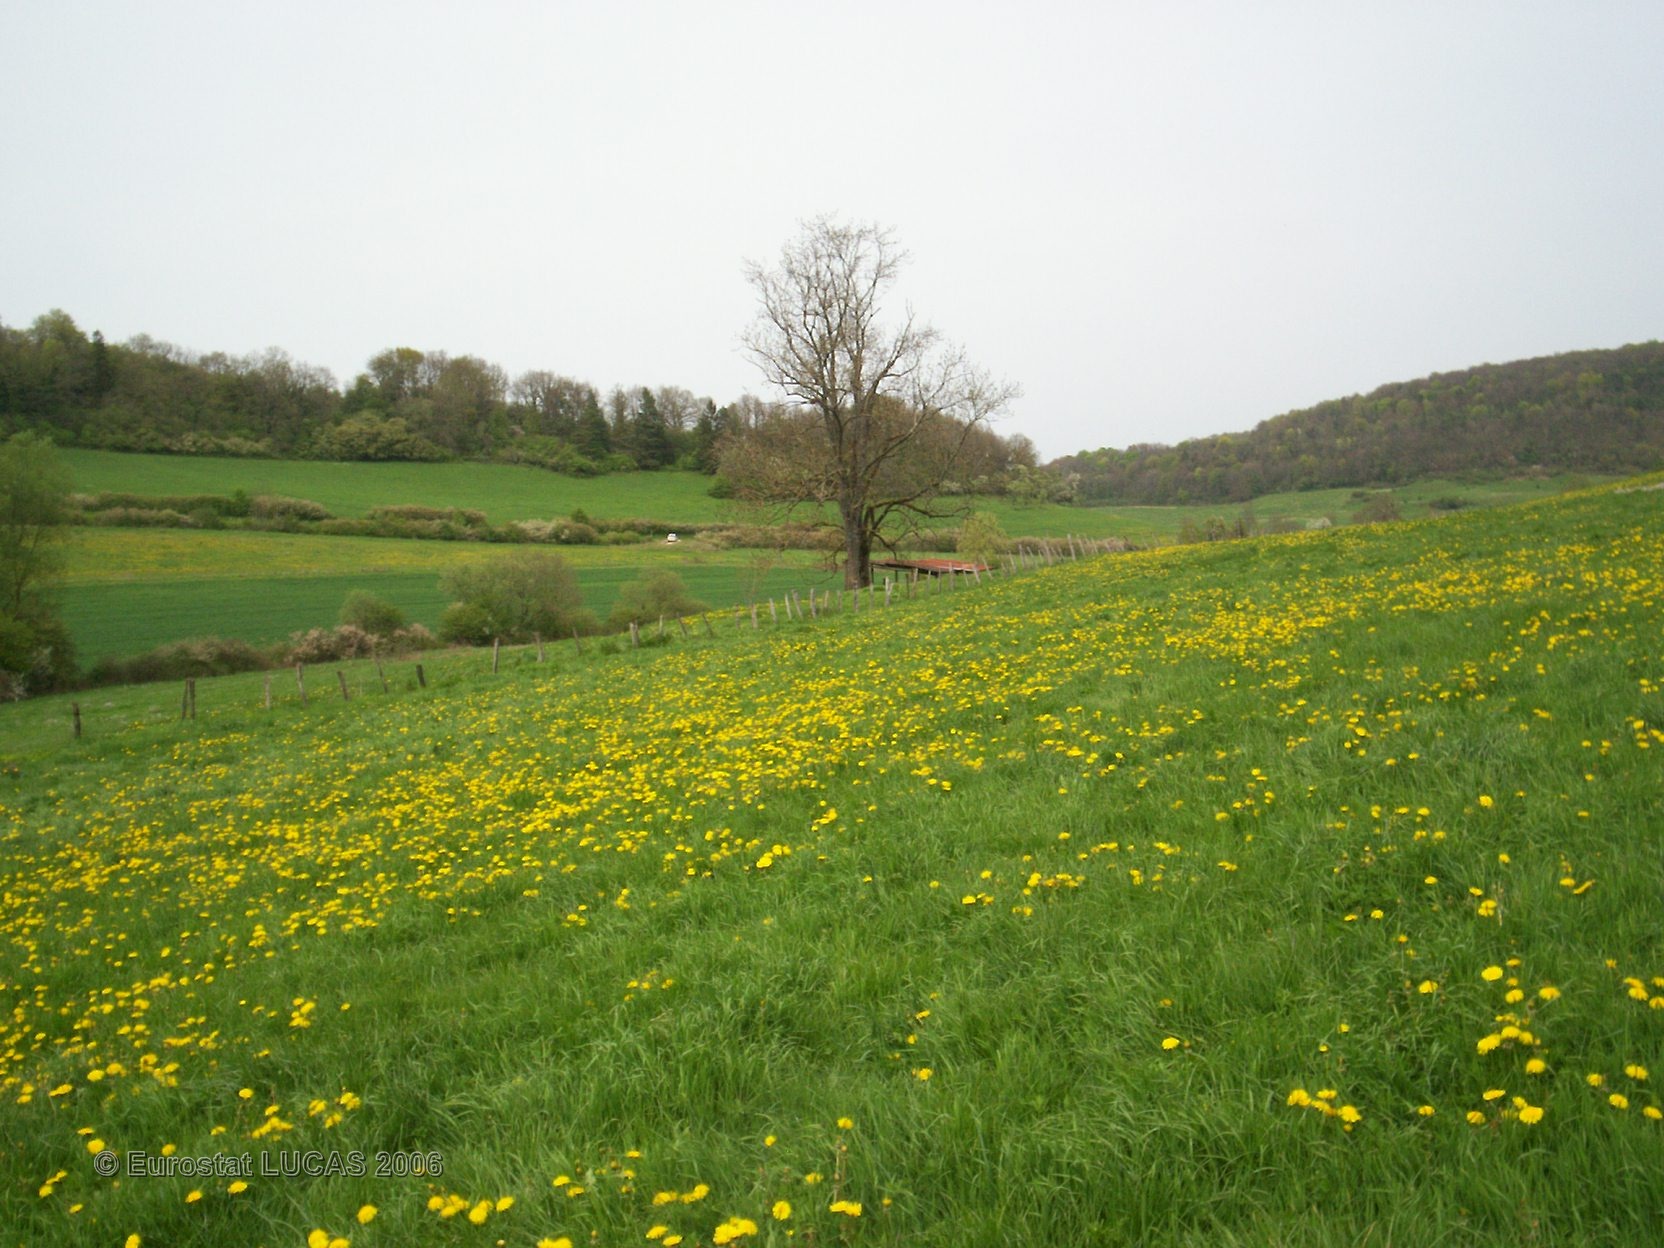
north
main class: Grassland
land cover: Grassland without tree/shrub cover
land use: Agriculture (excluding fallow land and kitchen gardens)
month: May
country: FR
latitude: 47.6946
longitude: 4.6025
